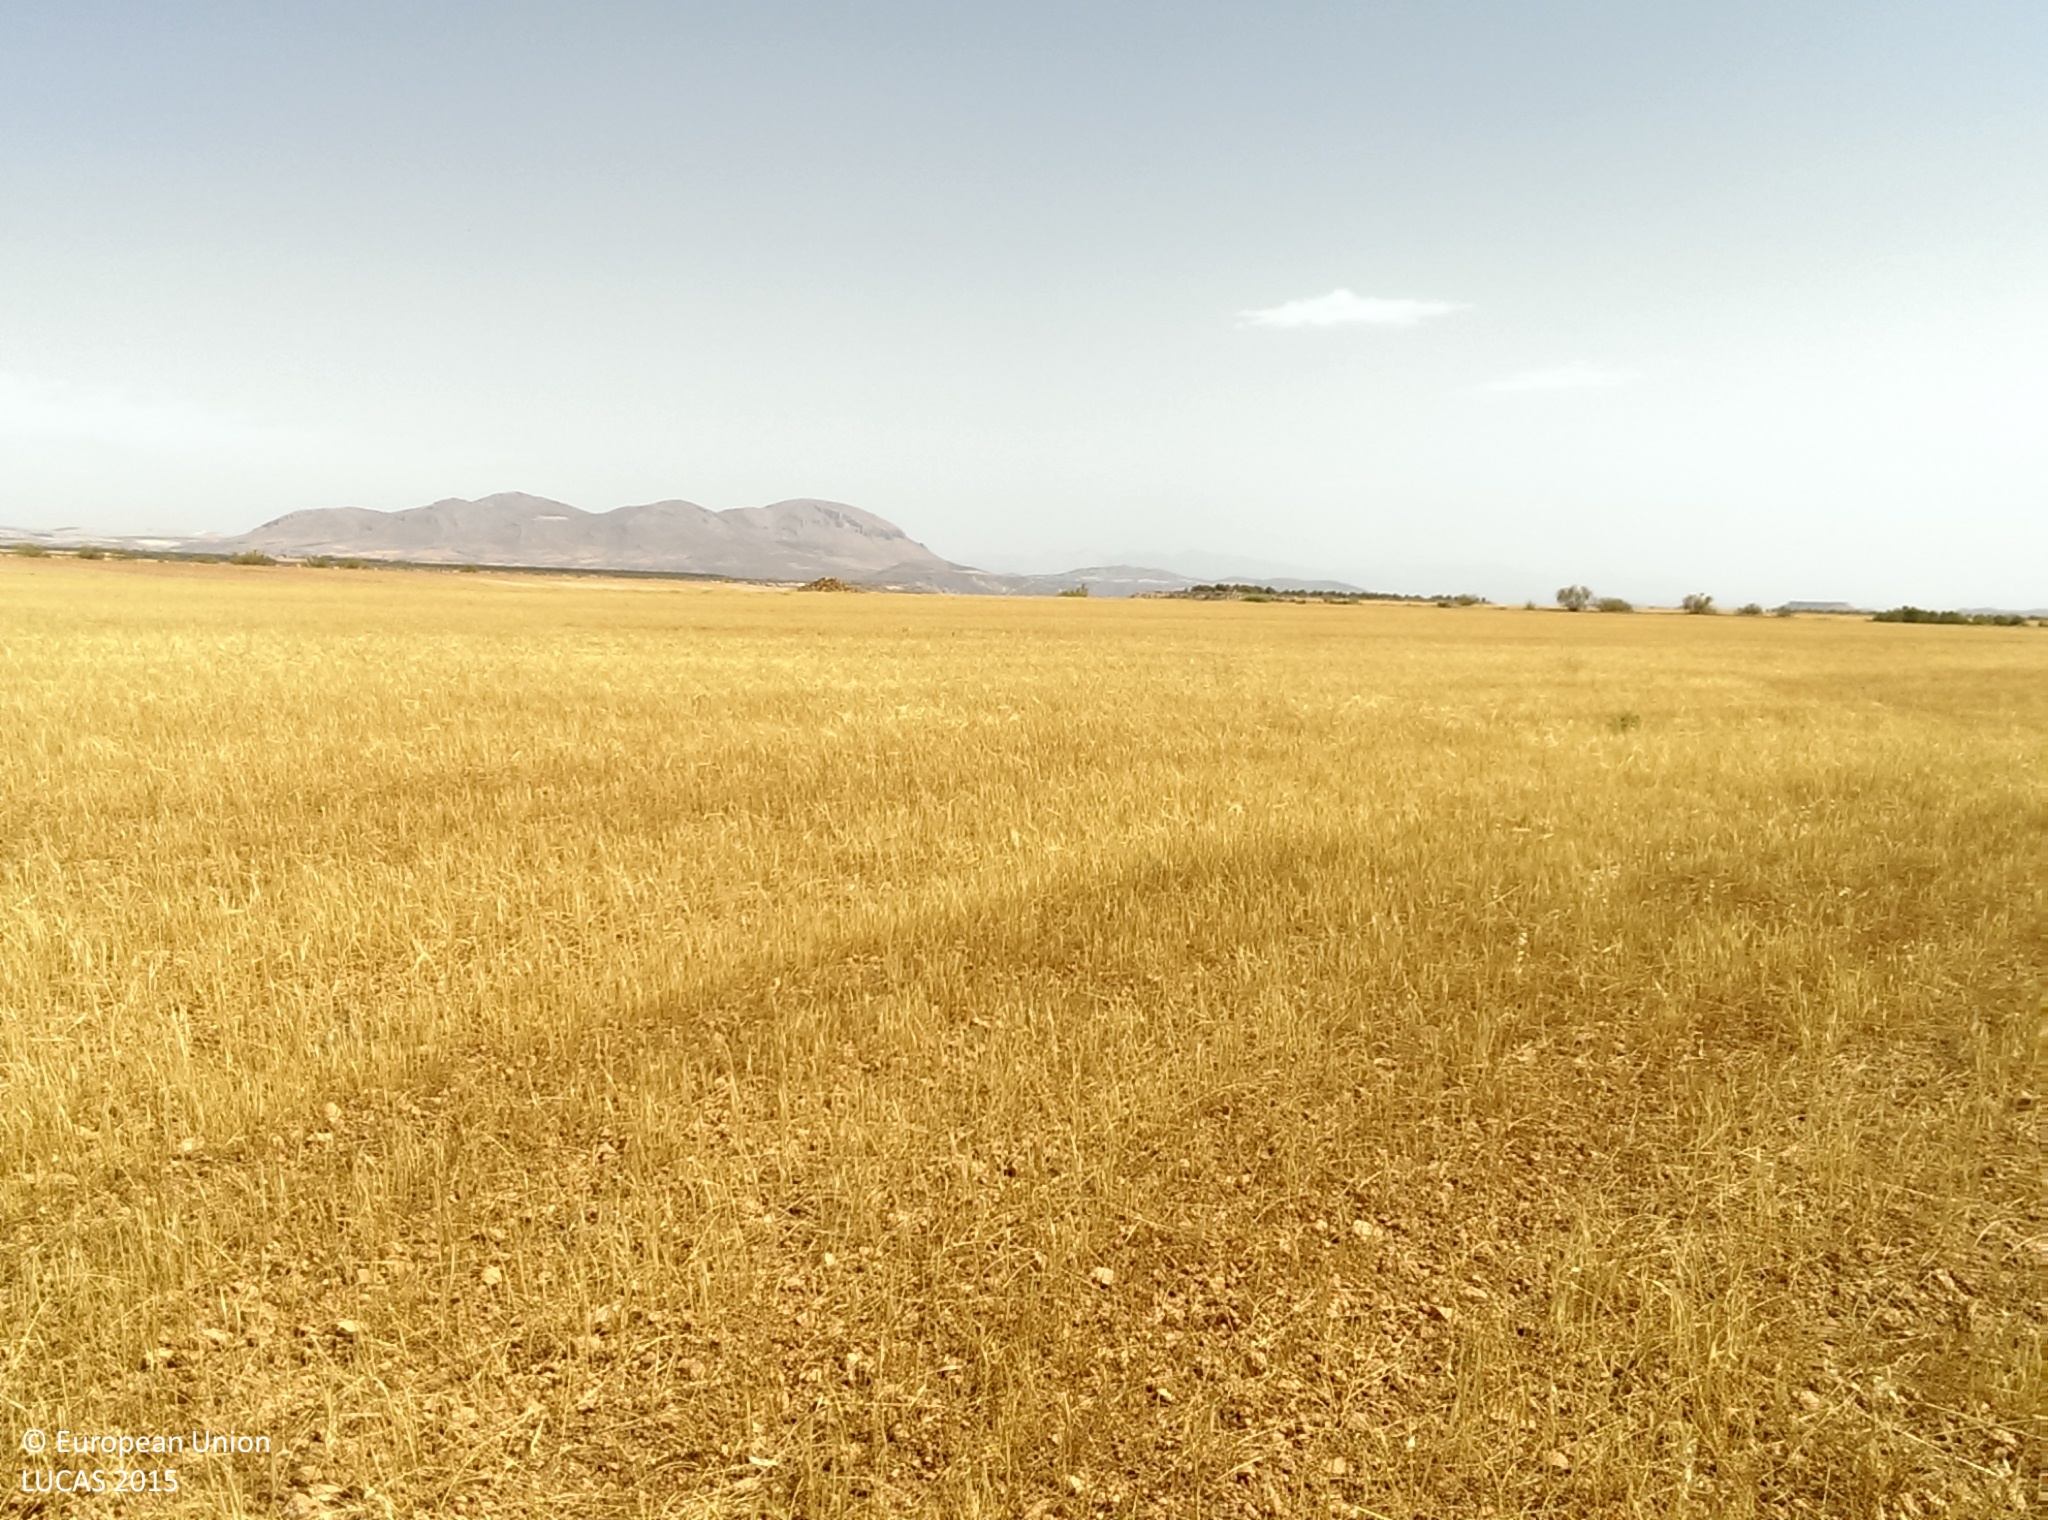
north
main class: Cropland
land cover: Barley
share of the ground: < 10 %
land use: Agriculture (excluding fallow land and kitchen gardens)
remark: Harvested field
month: July
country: ES
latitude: 37.3897
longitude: -3.2155
